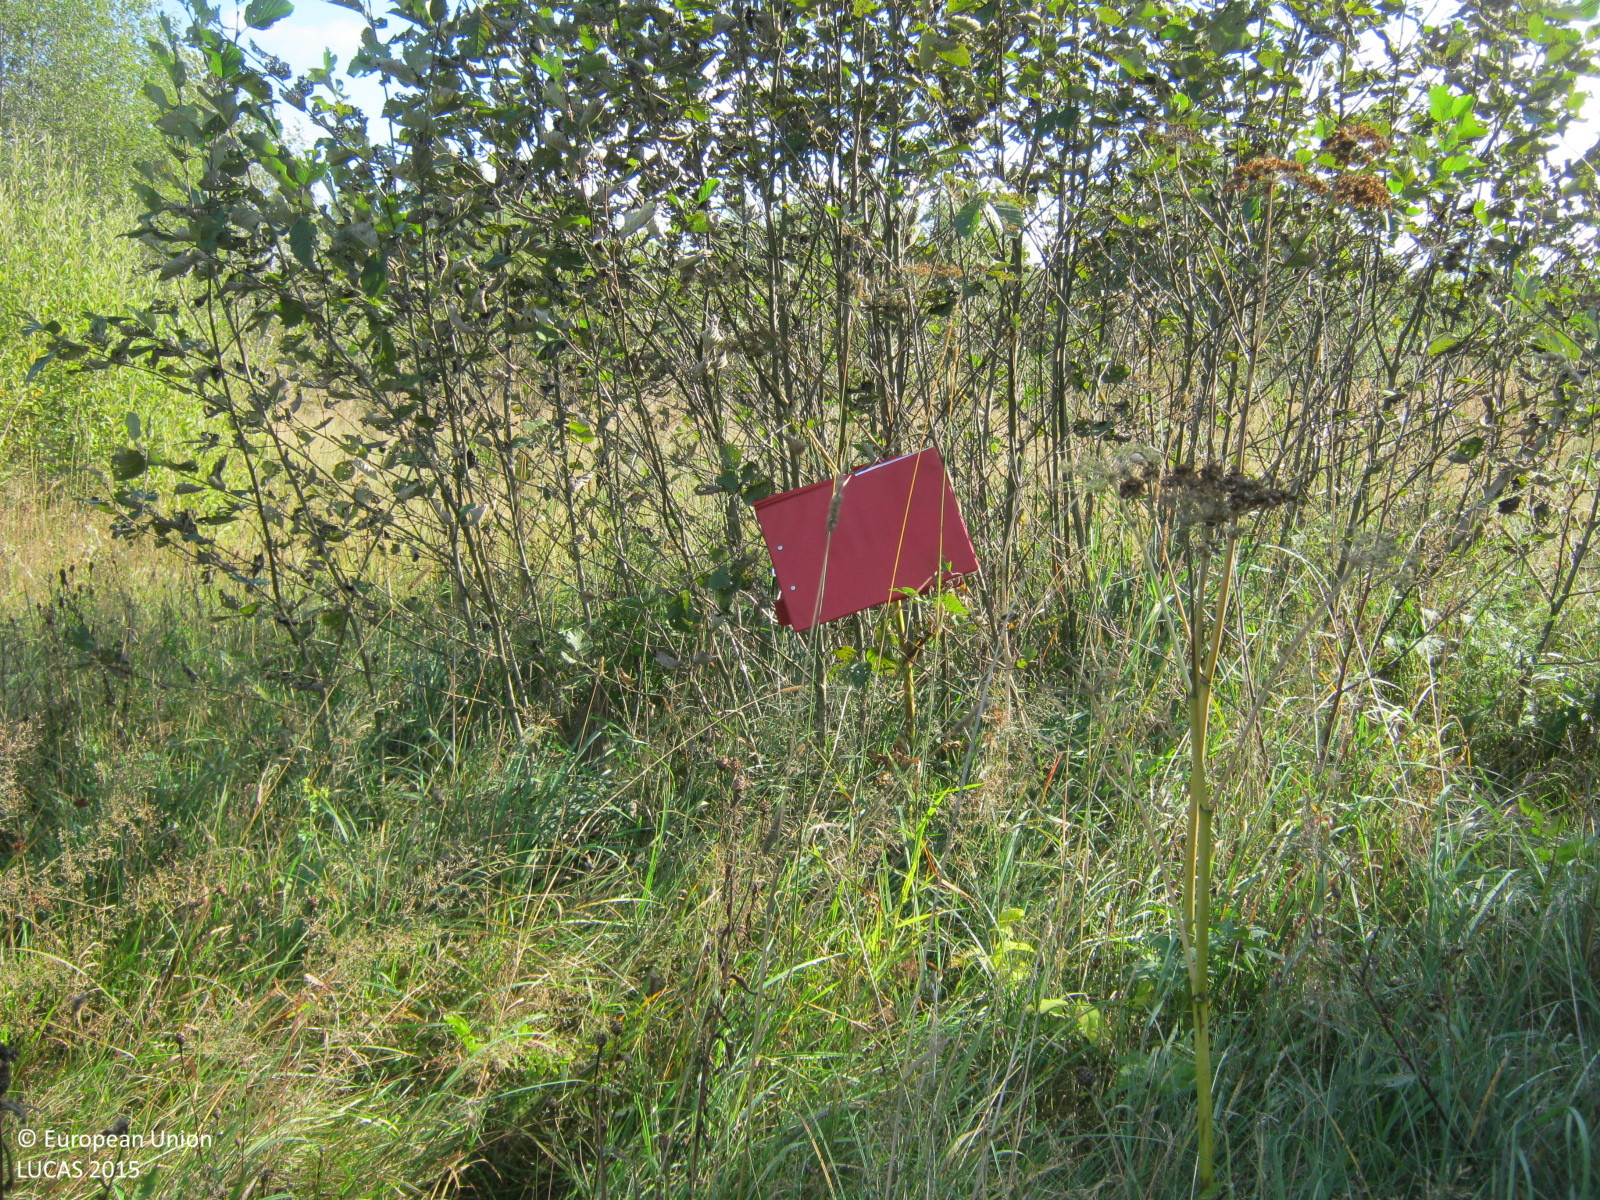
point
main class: Woodland
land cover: Broadleaved woodland
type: non-riverine alder, birch or aspen forest
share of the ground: 10 - 25 %
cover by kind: herbaceous plants 85 %, broadleaved forest trees 15 %
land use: Semi-natural and natural areas not in use
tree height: > 5 m
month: September
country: LV
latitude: 57.3923
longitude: 24.4833
